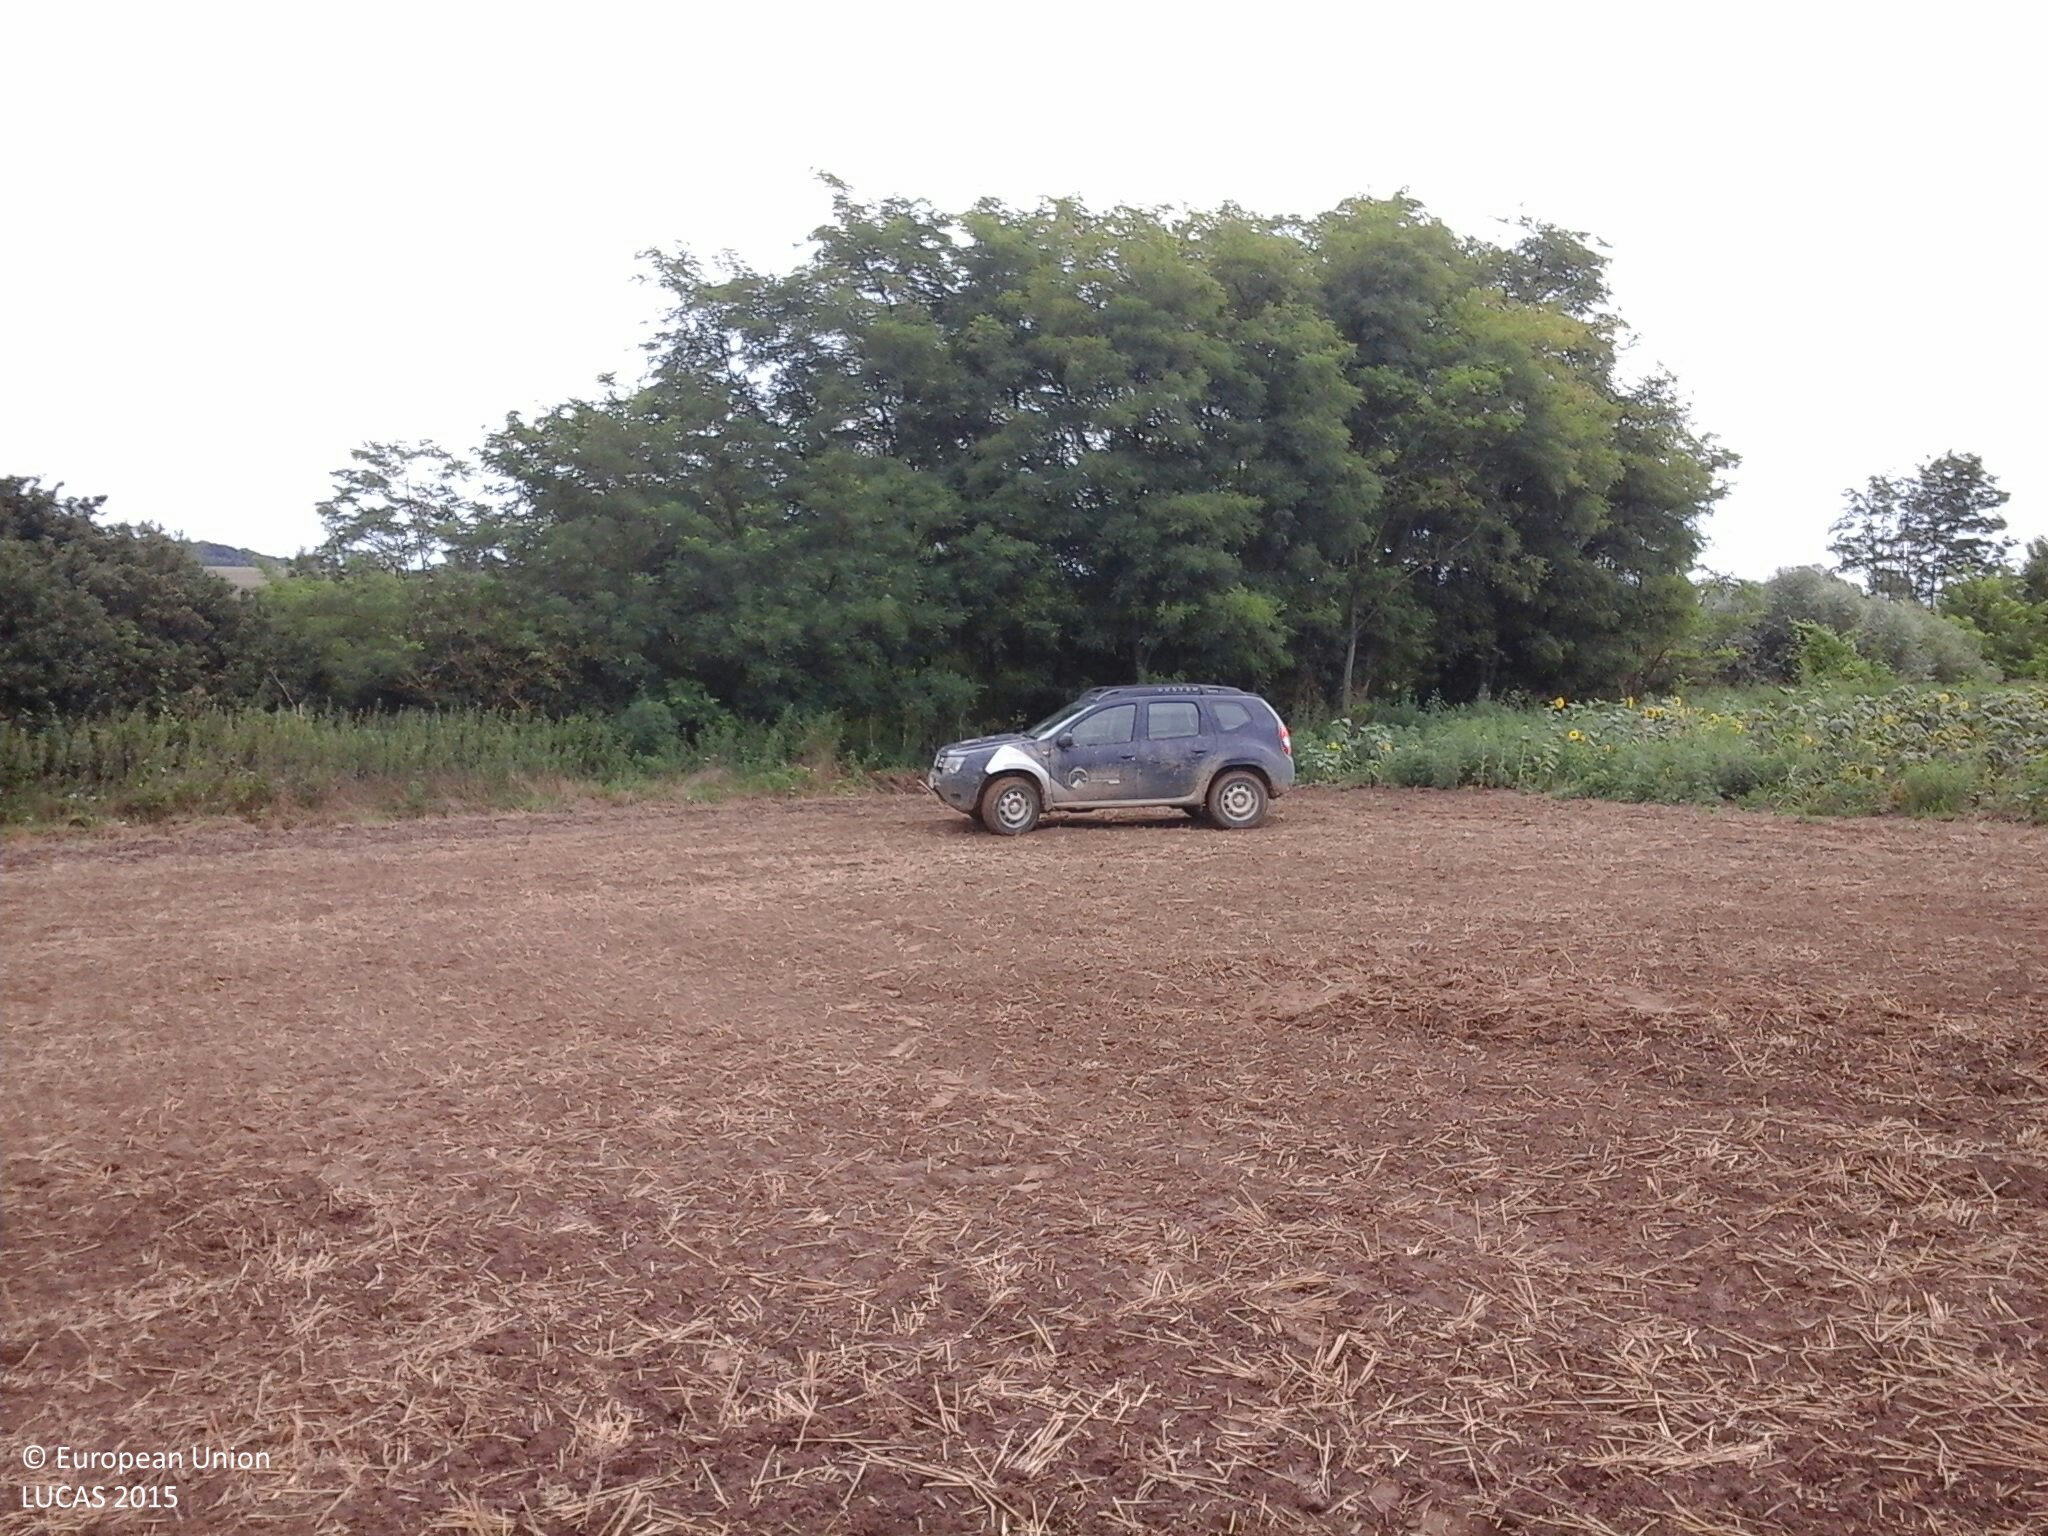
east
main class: Cropland
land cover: Common wheat
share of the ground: < 10 %
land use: Agriculture (excluding fallow land and kitchen gardens)
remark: Harvested field
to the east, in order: Common wheat; Shrubland with sparse tree cover; Ditches and canals; Grass margins; Railways; Grass margins; Shrubland with sparse tree cover; Tracks; Shrubland with sparse tree cover
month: July
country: HU
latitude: 46.6567
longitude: 17.8873
